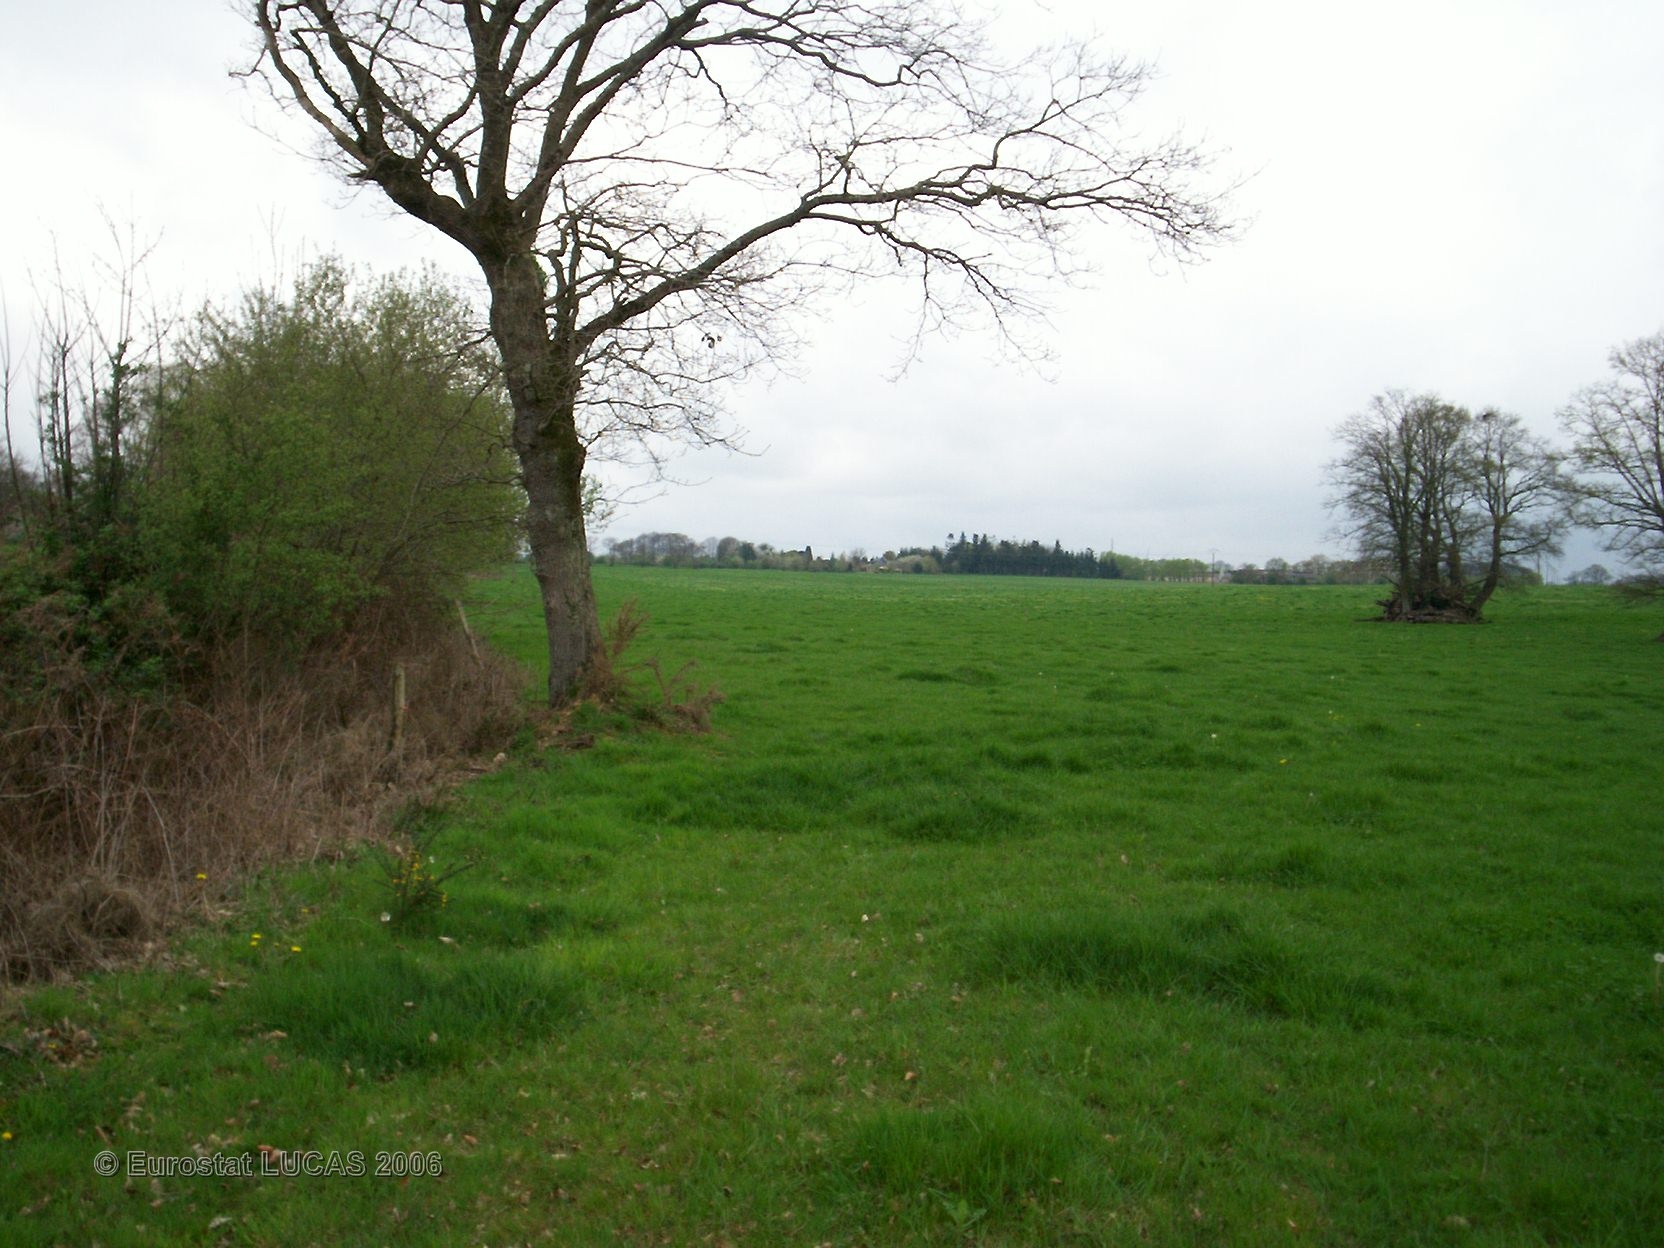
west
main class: Grassland
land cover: Grassland without tree/shrub cover
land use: Agriculture (excluding fallow land and kitchen gardens)
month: April
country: FR
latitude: 48.0821
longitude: -2.4221
